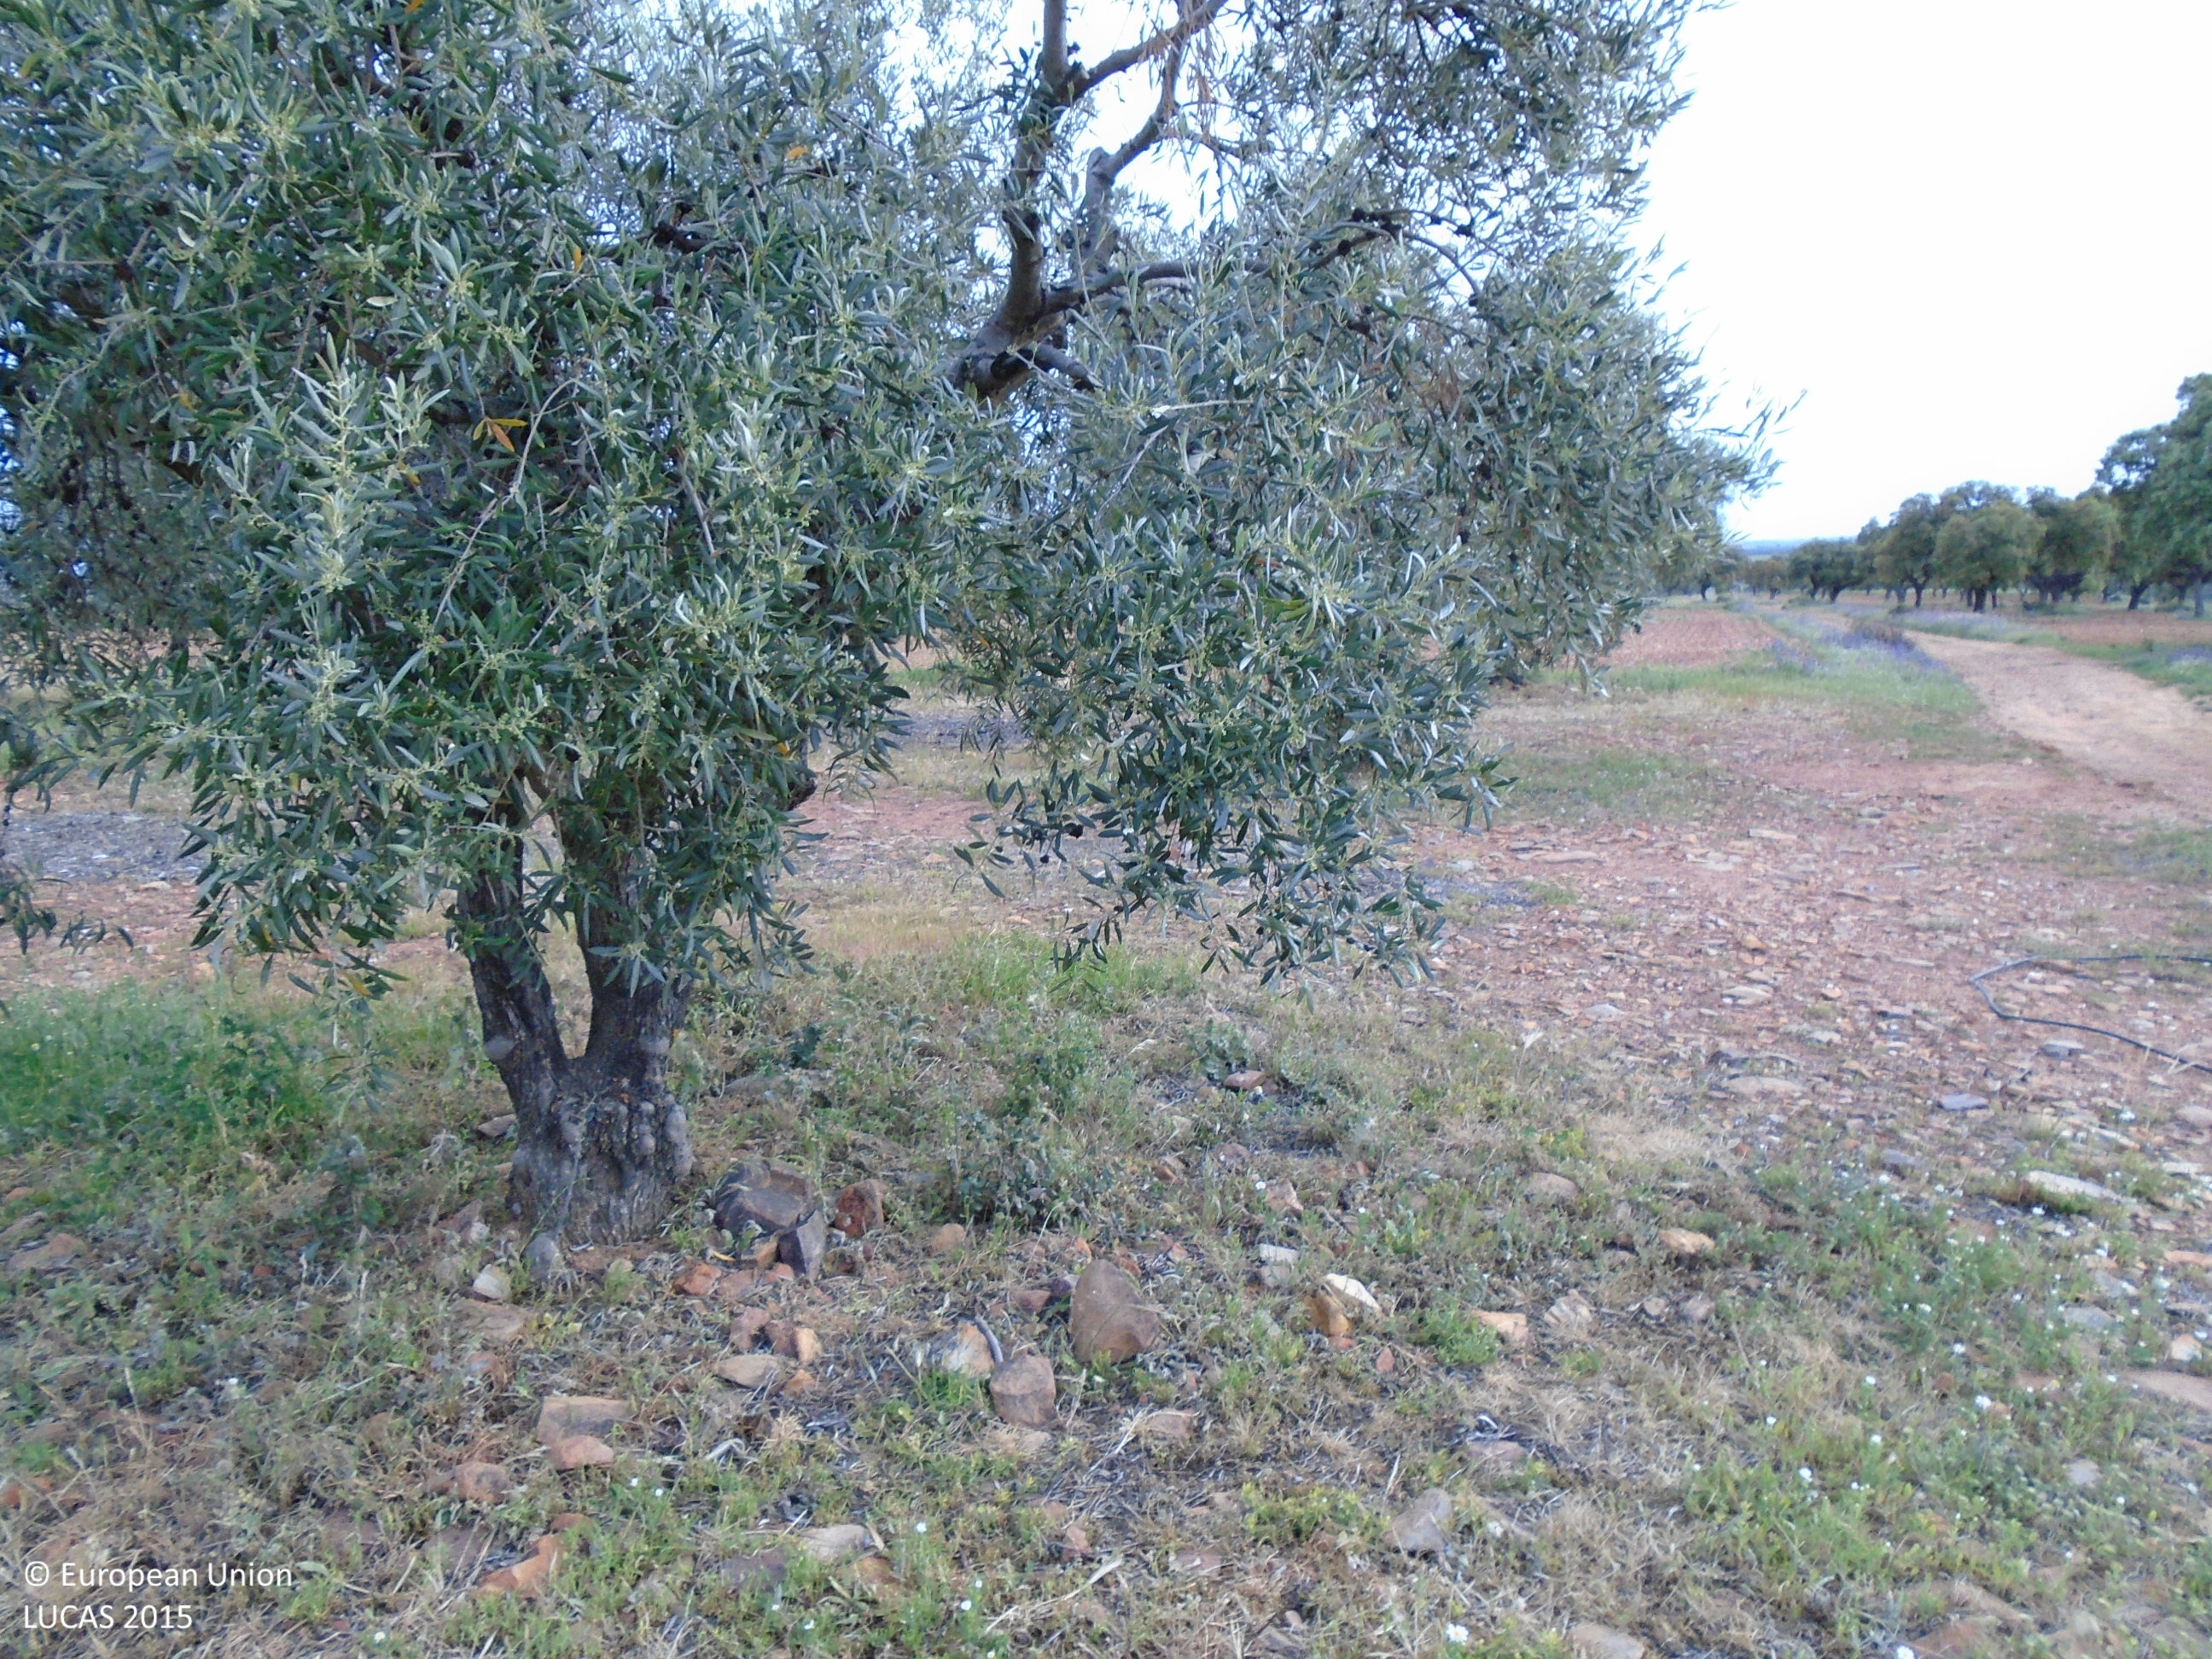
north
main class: Cropland
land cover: Olive groves
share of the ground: 10 - 25 %
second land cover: Other bare soil
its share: > 75 %
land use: Agriculture (excluding fallow land and kitchen gardens)
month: May
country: ES
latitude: 39.6821
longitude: -4.6027
